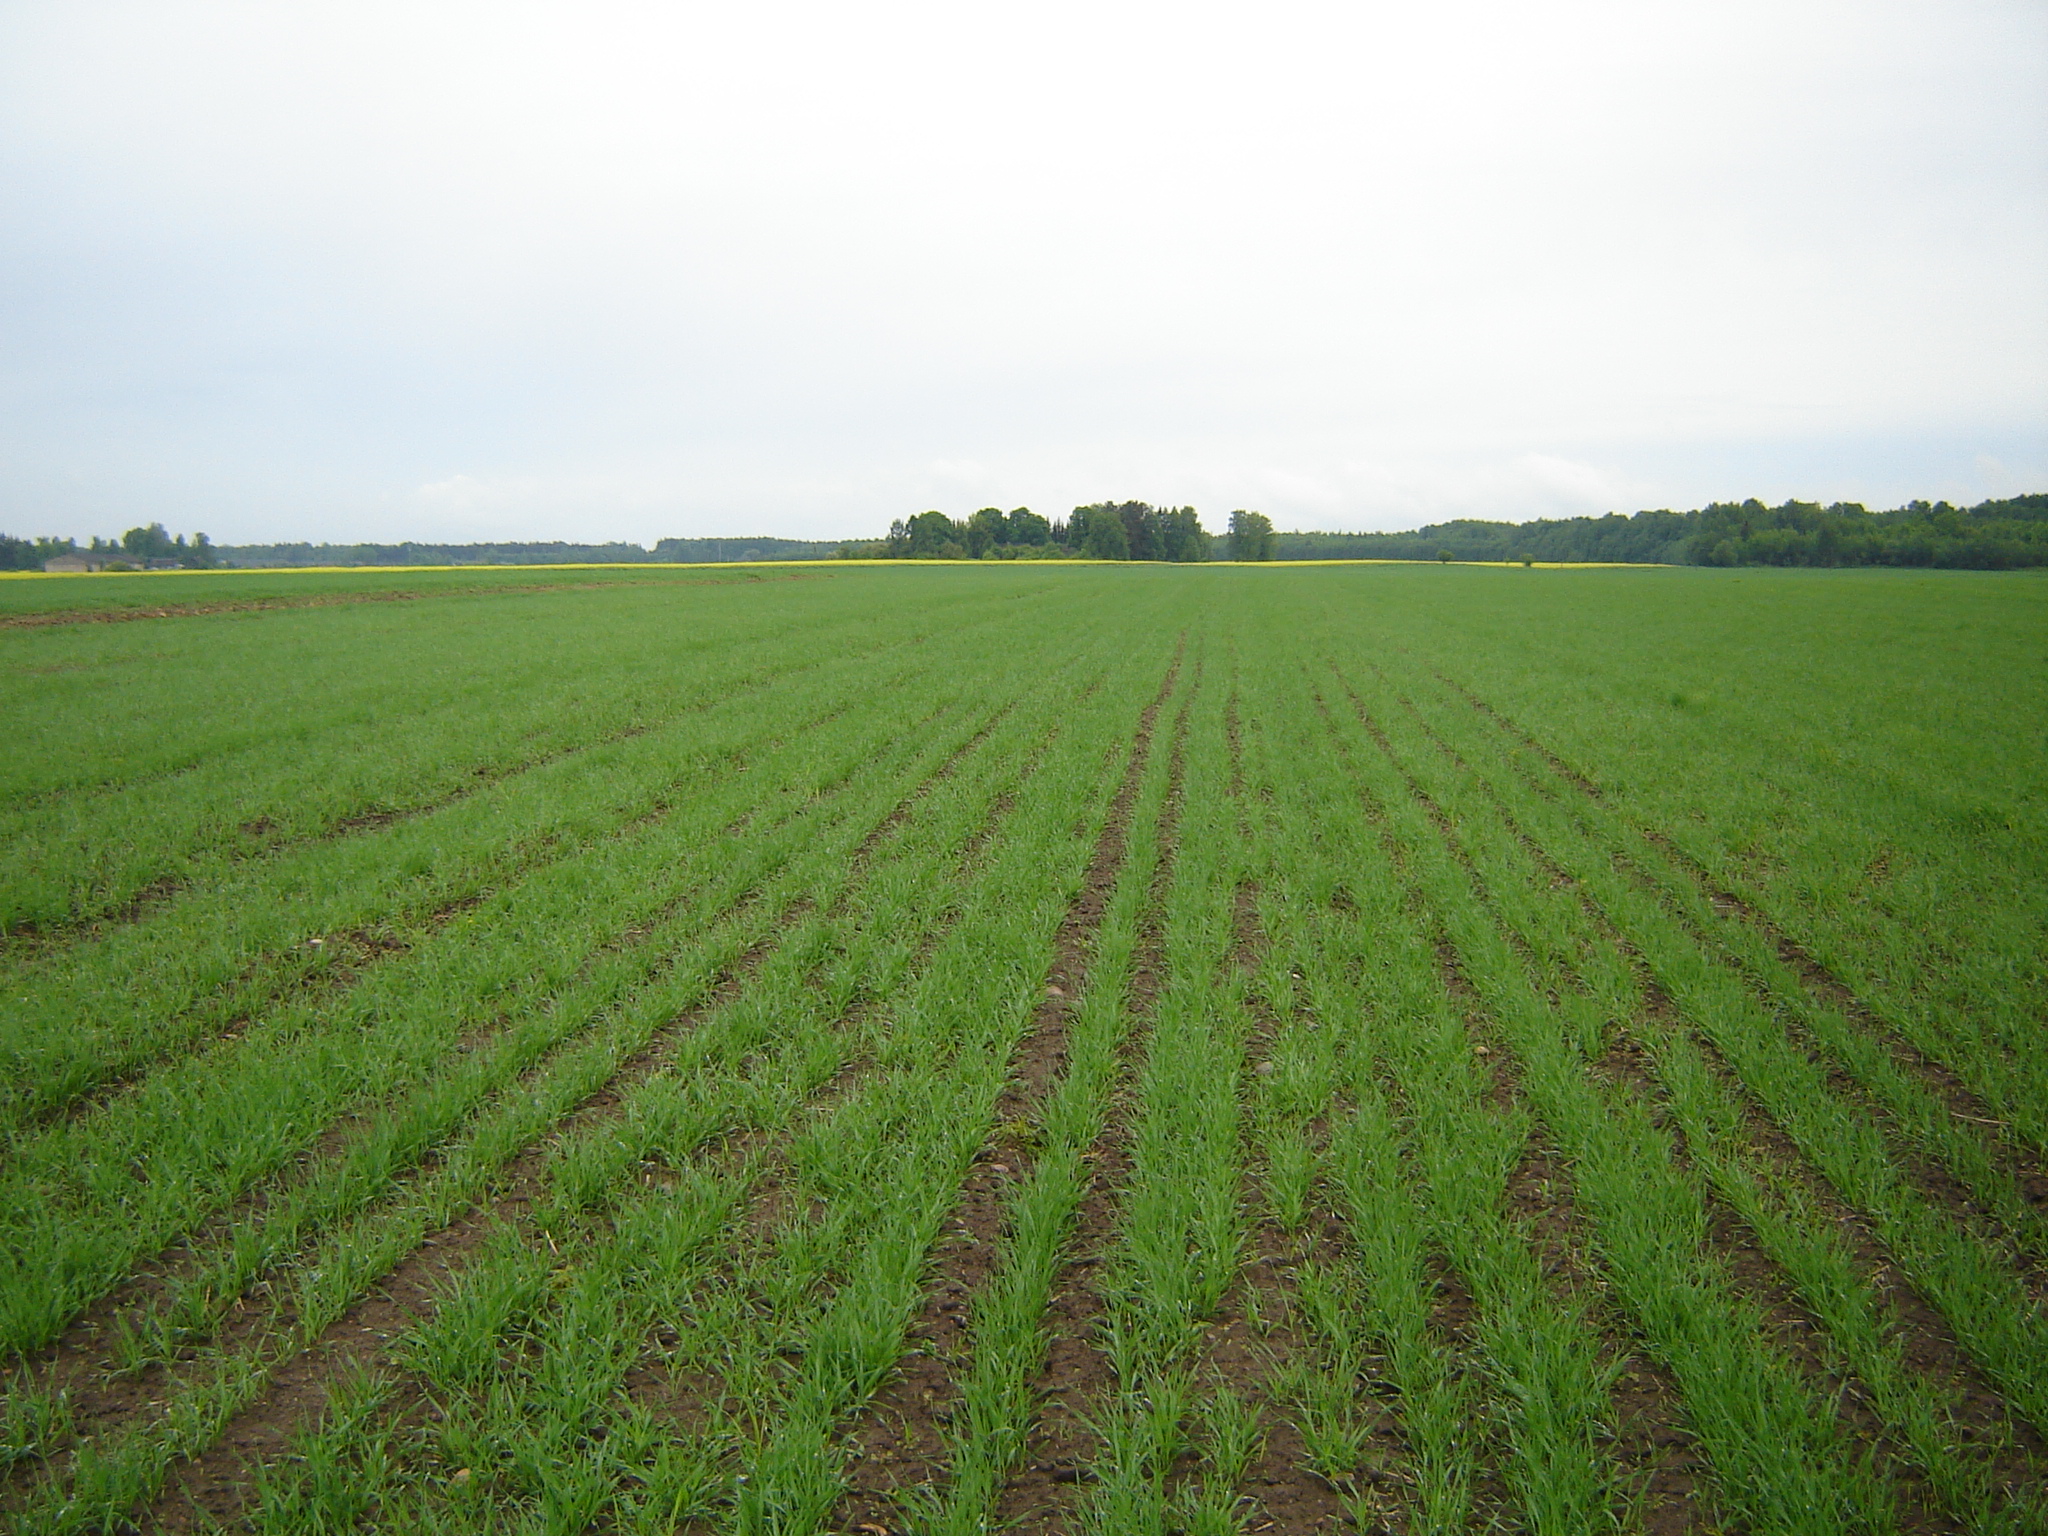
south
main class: Cropland
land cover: Common wheat
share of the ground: 50 - 75 %
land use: Agriculture (excluding fallow land and kitchen gardens)
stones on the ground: < 10 %
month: May
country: LT
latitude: 55.8809
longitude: 25.1894
